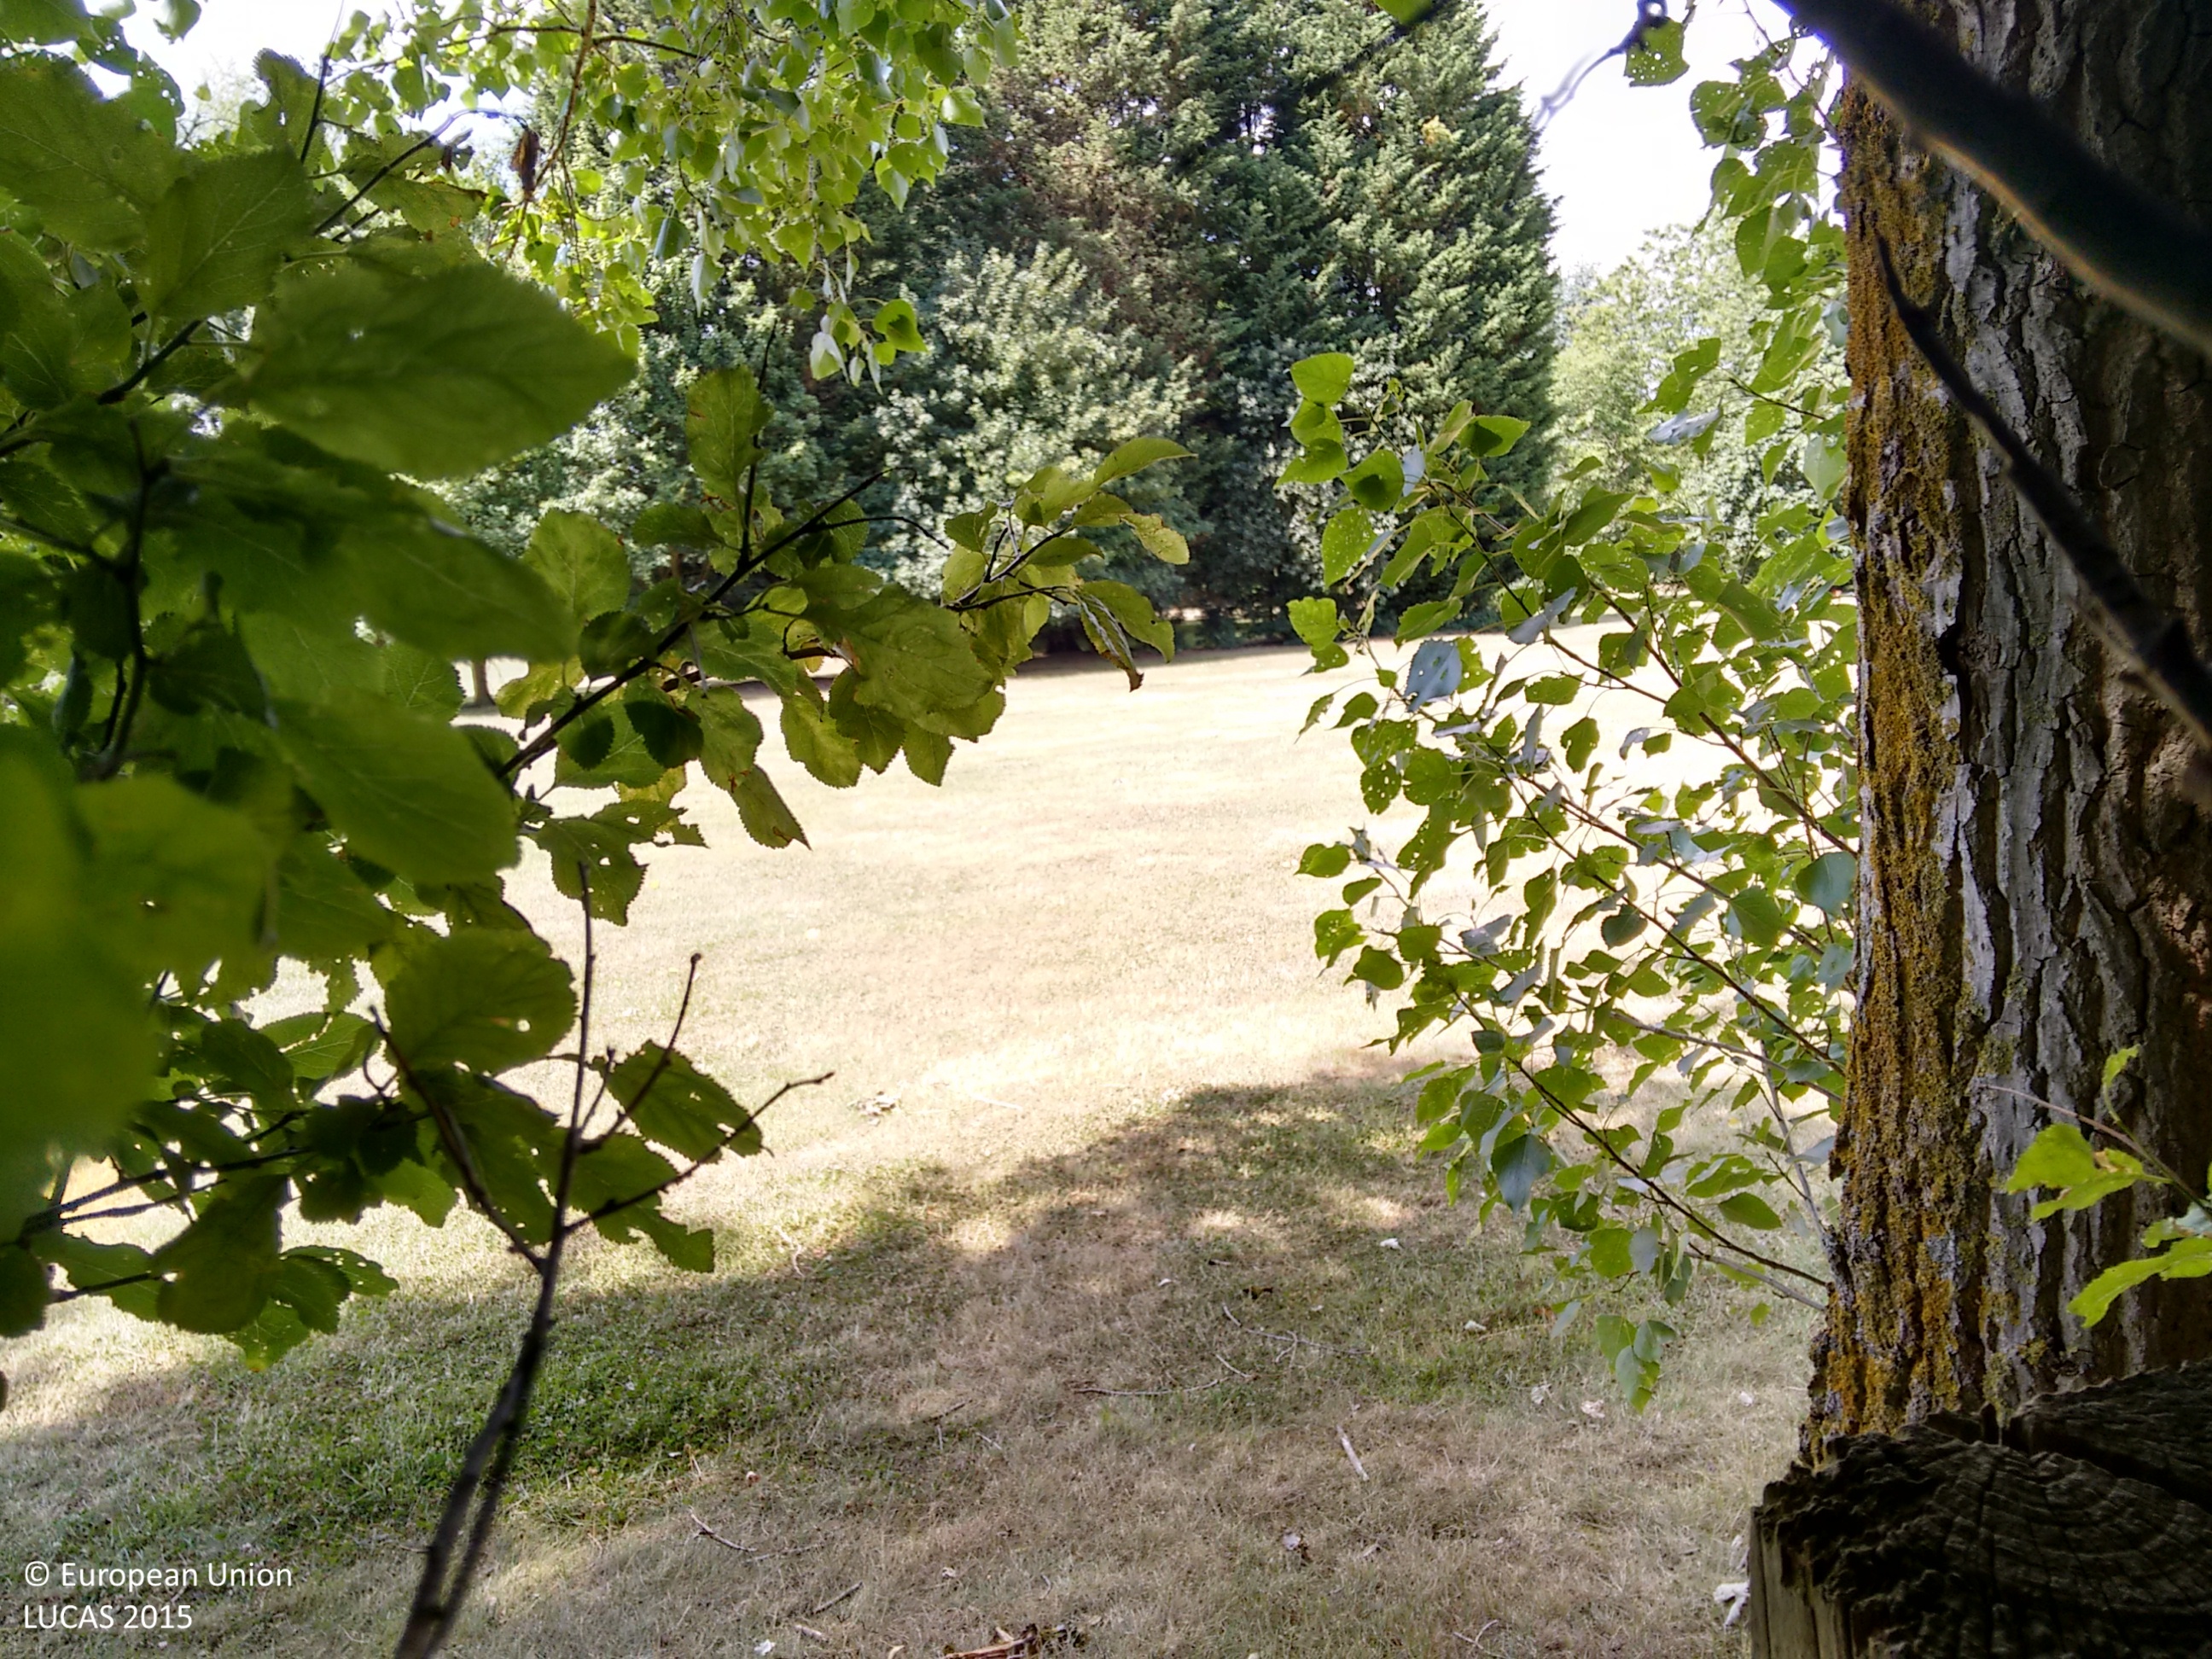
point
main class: Woodland
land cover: Broadleaved woodland
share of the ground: > 75 %
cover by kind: herbaceous plants 85 %, broadleaved forest trees 15 %
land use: Sport
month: July
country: GB
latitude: 52.5637
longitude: -0.2884
